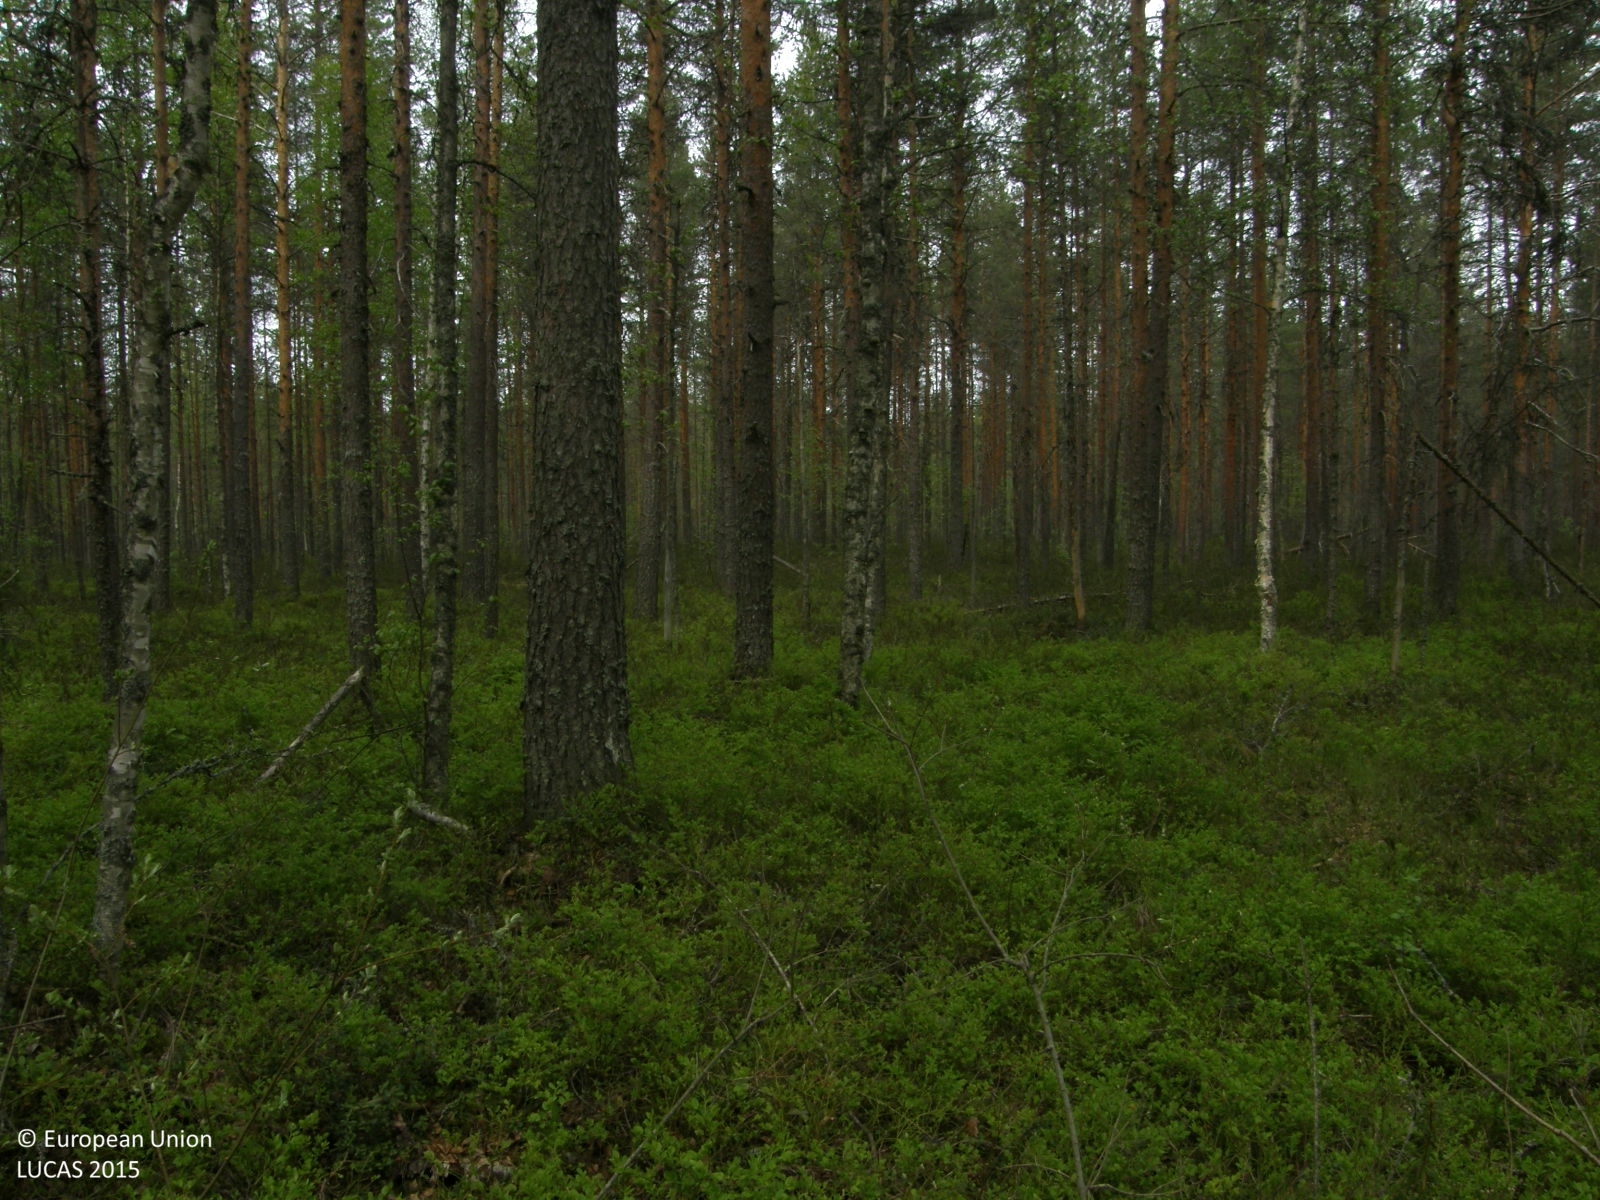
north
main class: Woodland
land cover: Pine dominated mixed woodland
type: boreal forest
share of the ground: > 75 %
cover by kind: coniferous forest trees 55 %, broadleaved forest trees 35 %, shrubs 10 %
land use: Forestry
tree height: > 5 m
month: June
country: FI
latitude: 62.0643
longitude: 22.3605
